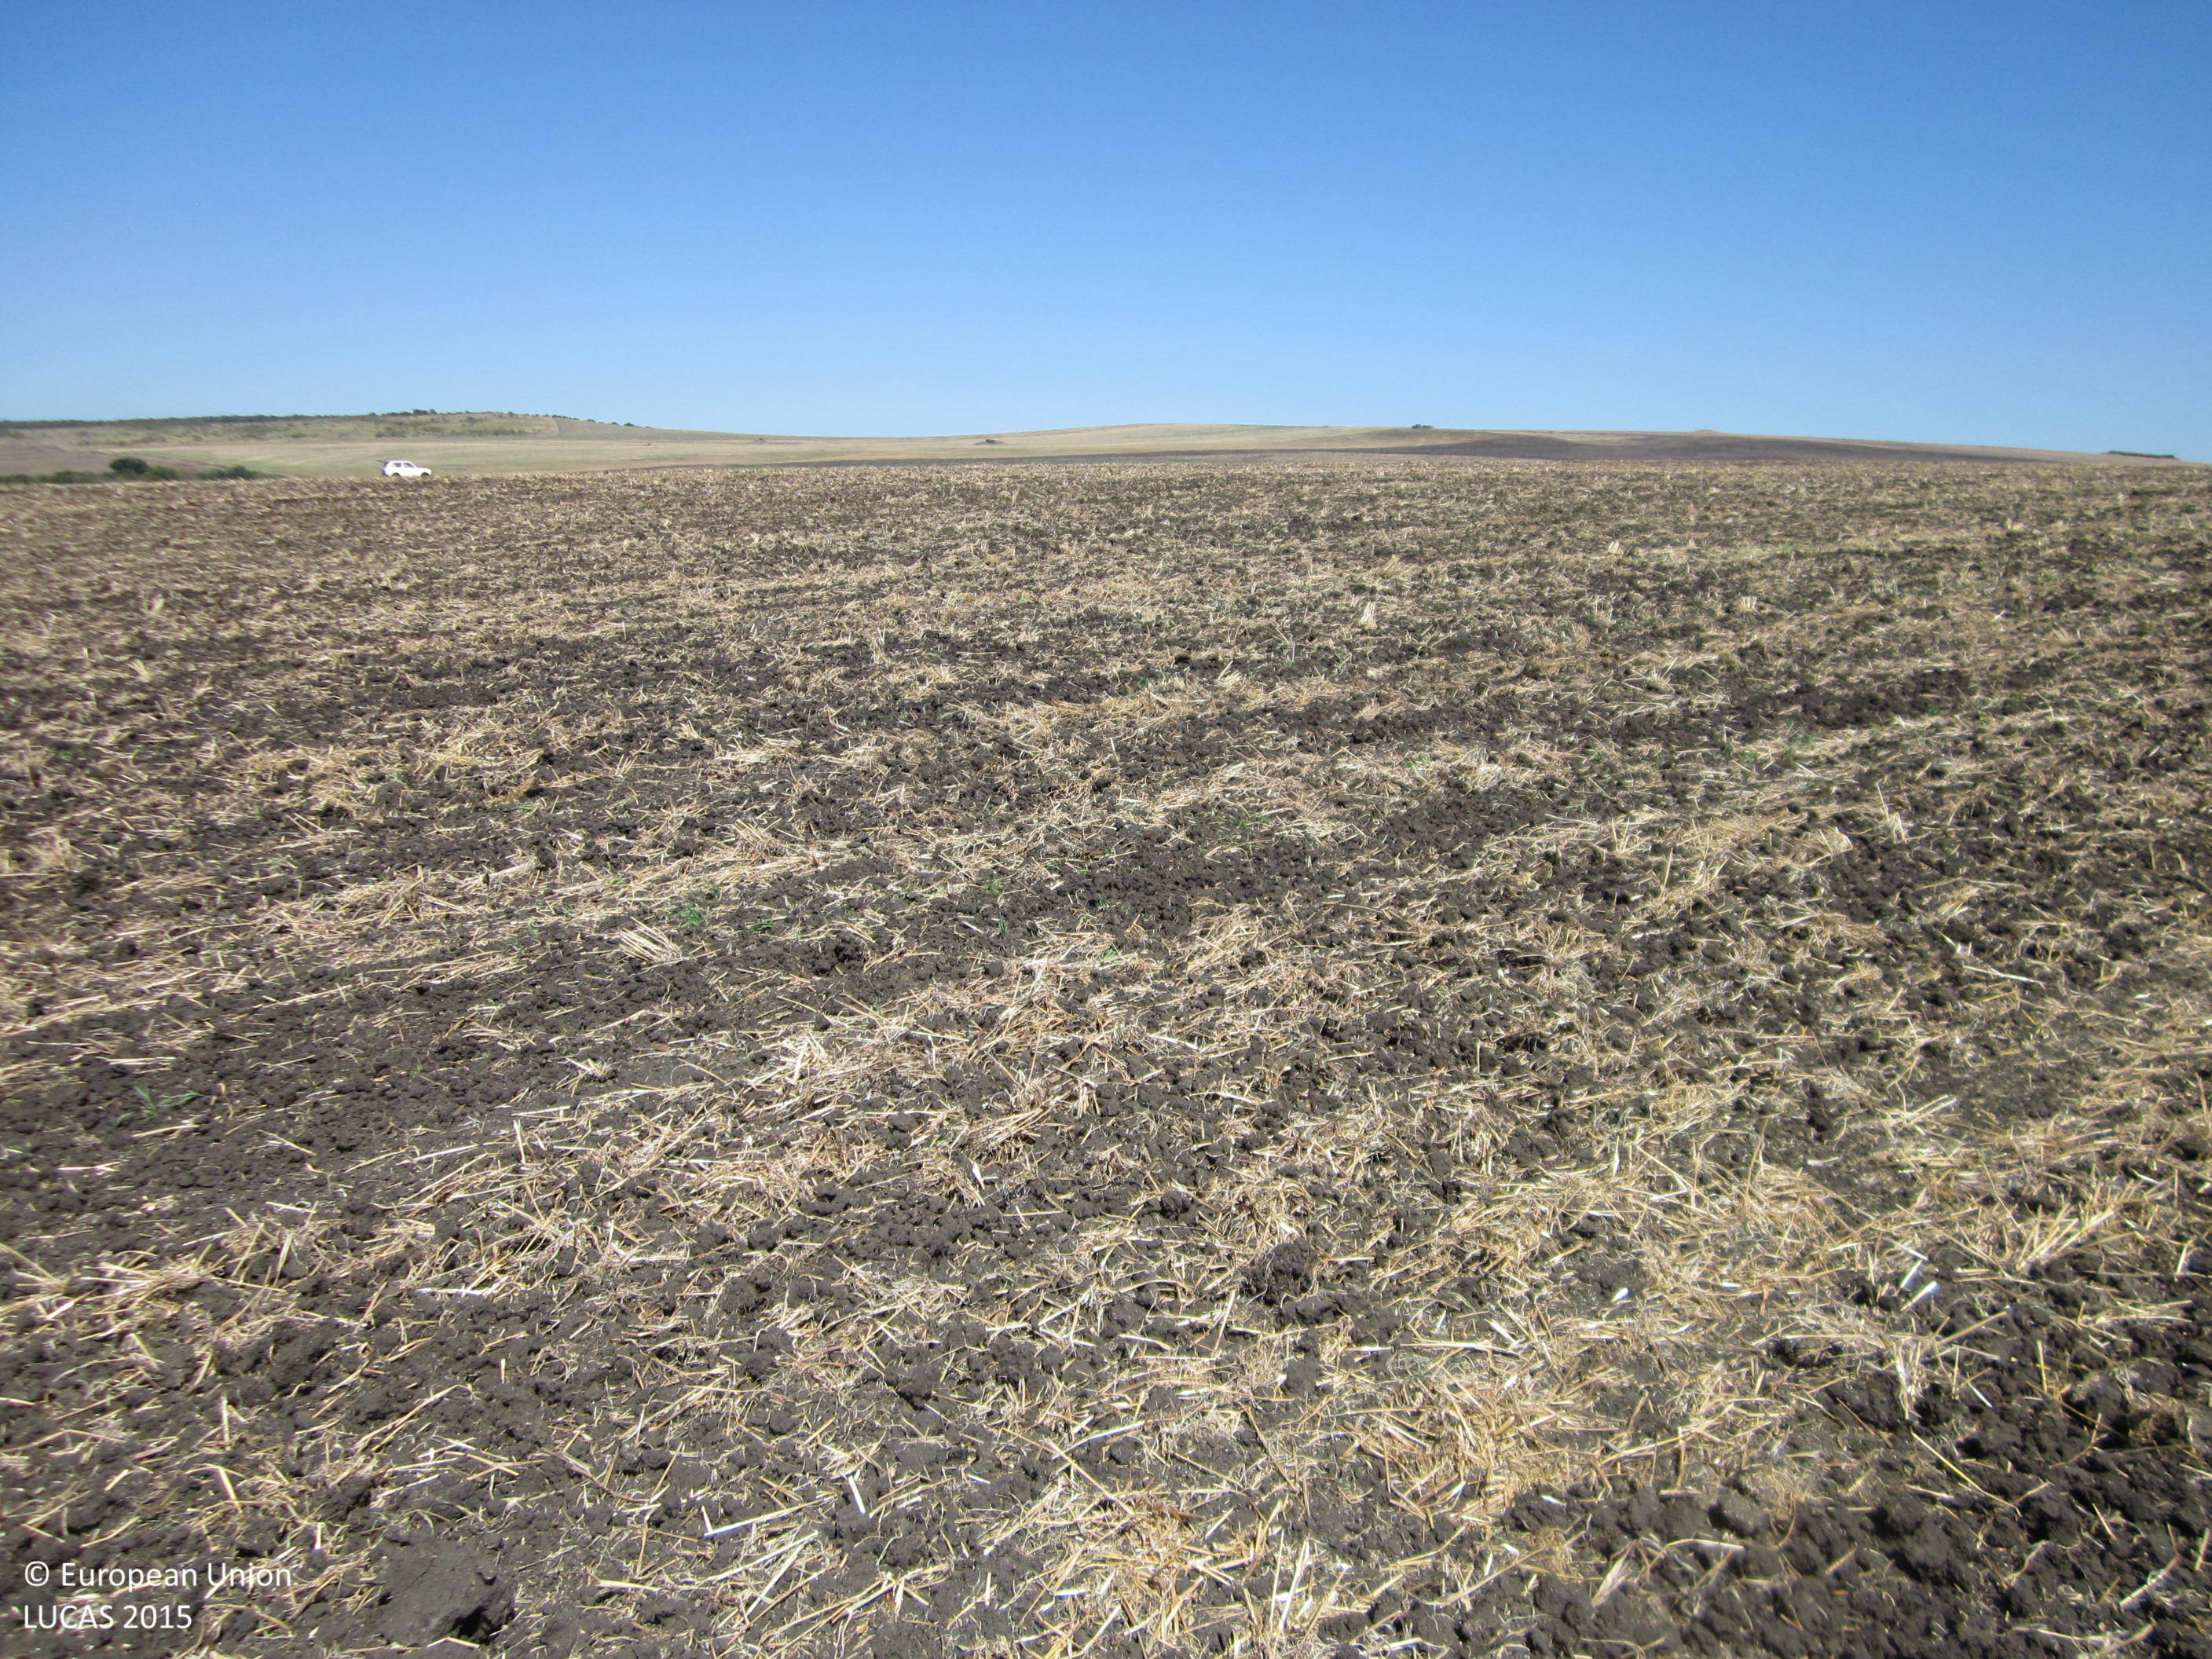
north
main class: Cropland
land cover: Common wheat
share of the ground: 10 - 25 %
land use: Agriculture (excluding fallow land and kitchen gardens)
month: September
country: BG
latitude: 42.5587
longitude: 27.0490
